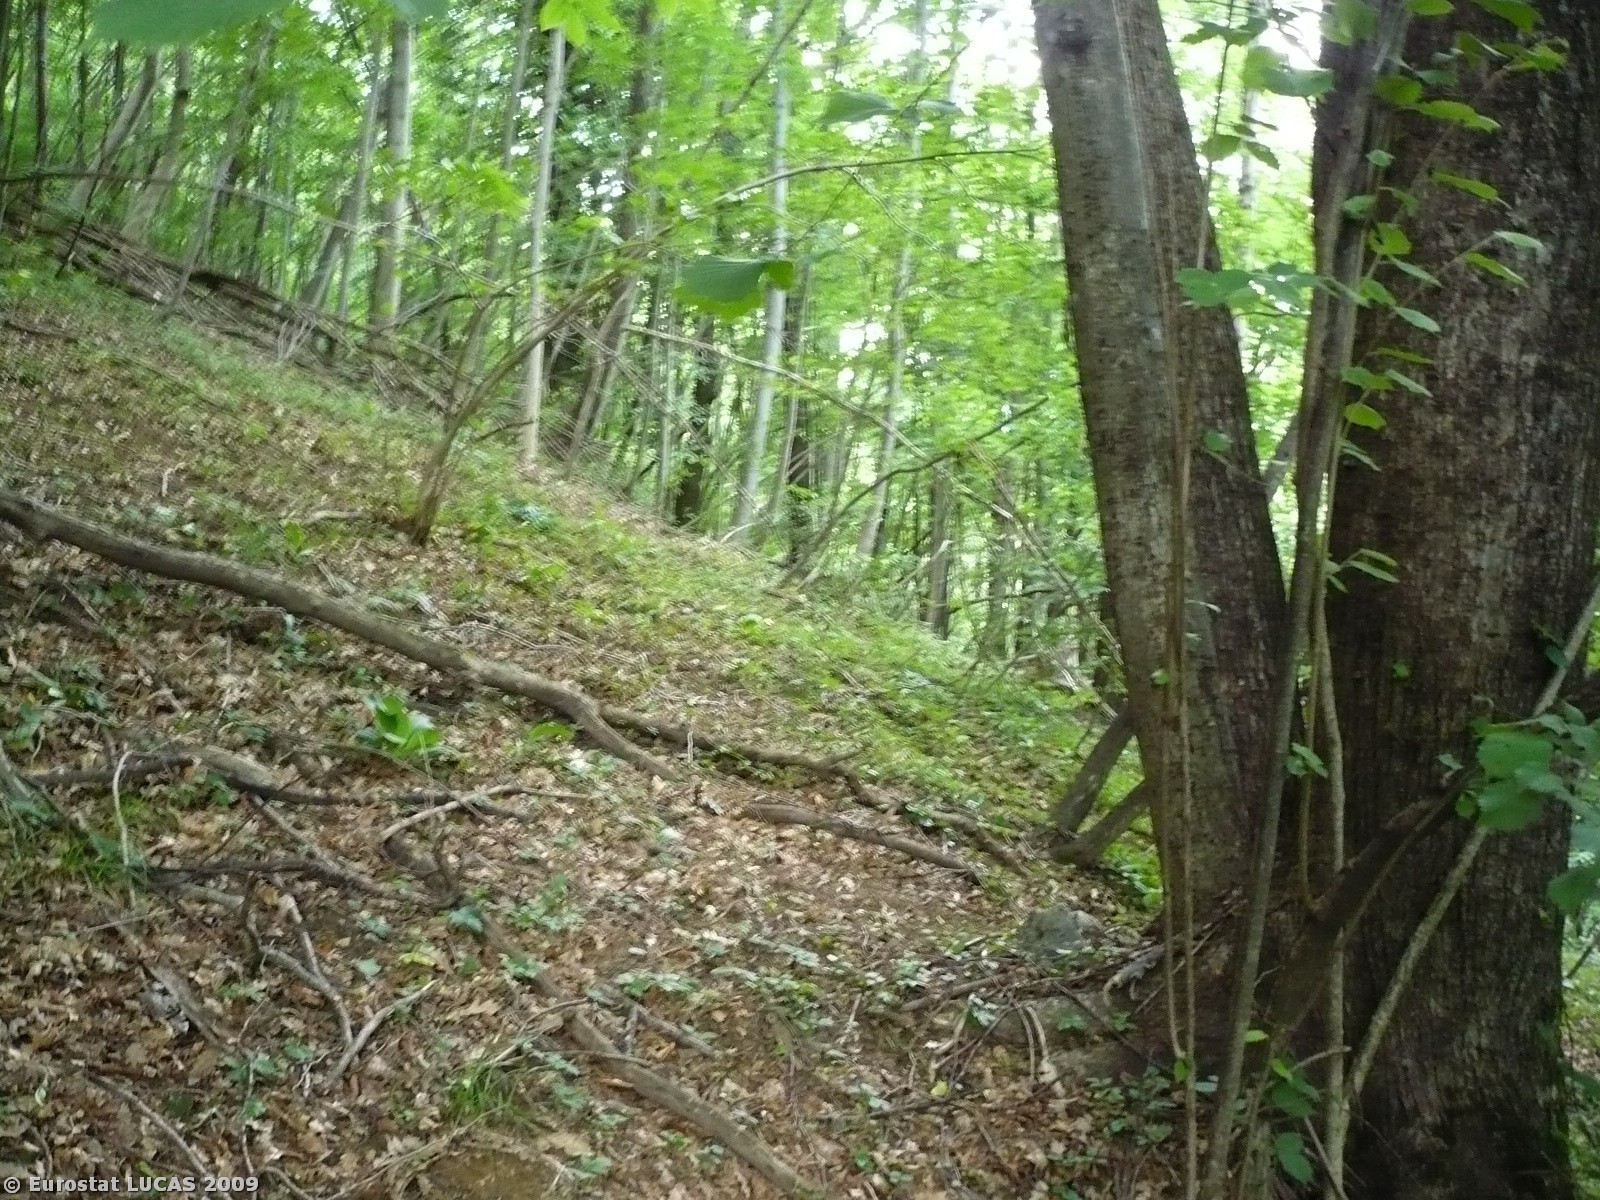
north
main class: Woodland
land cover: Broadleaved woodland
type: beech forest
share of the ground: > 75 %
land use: Unused
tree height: > 5 m
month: June
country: SI
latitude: 46.1255
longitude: 13.6848
